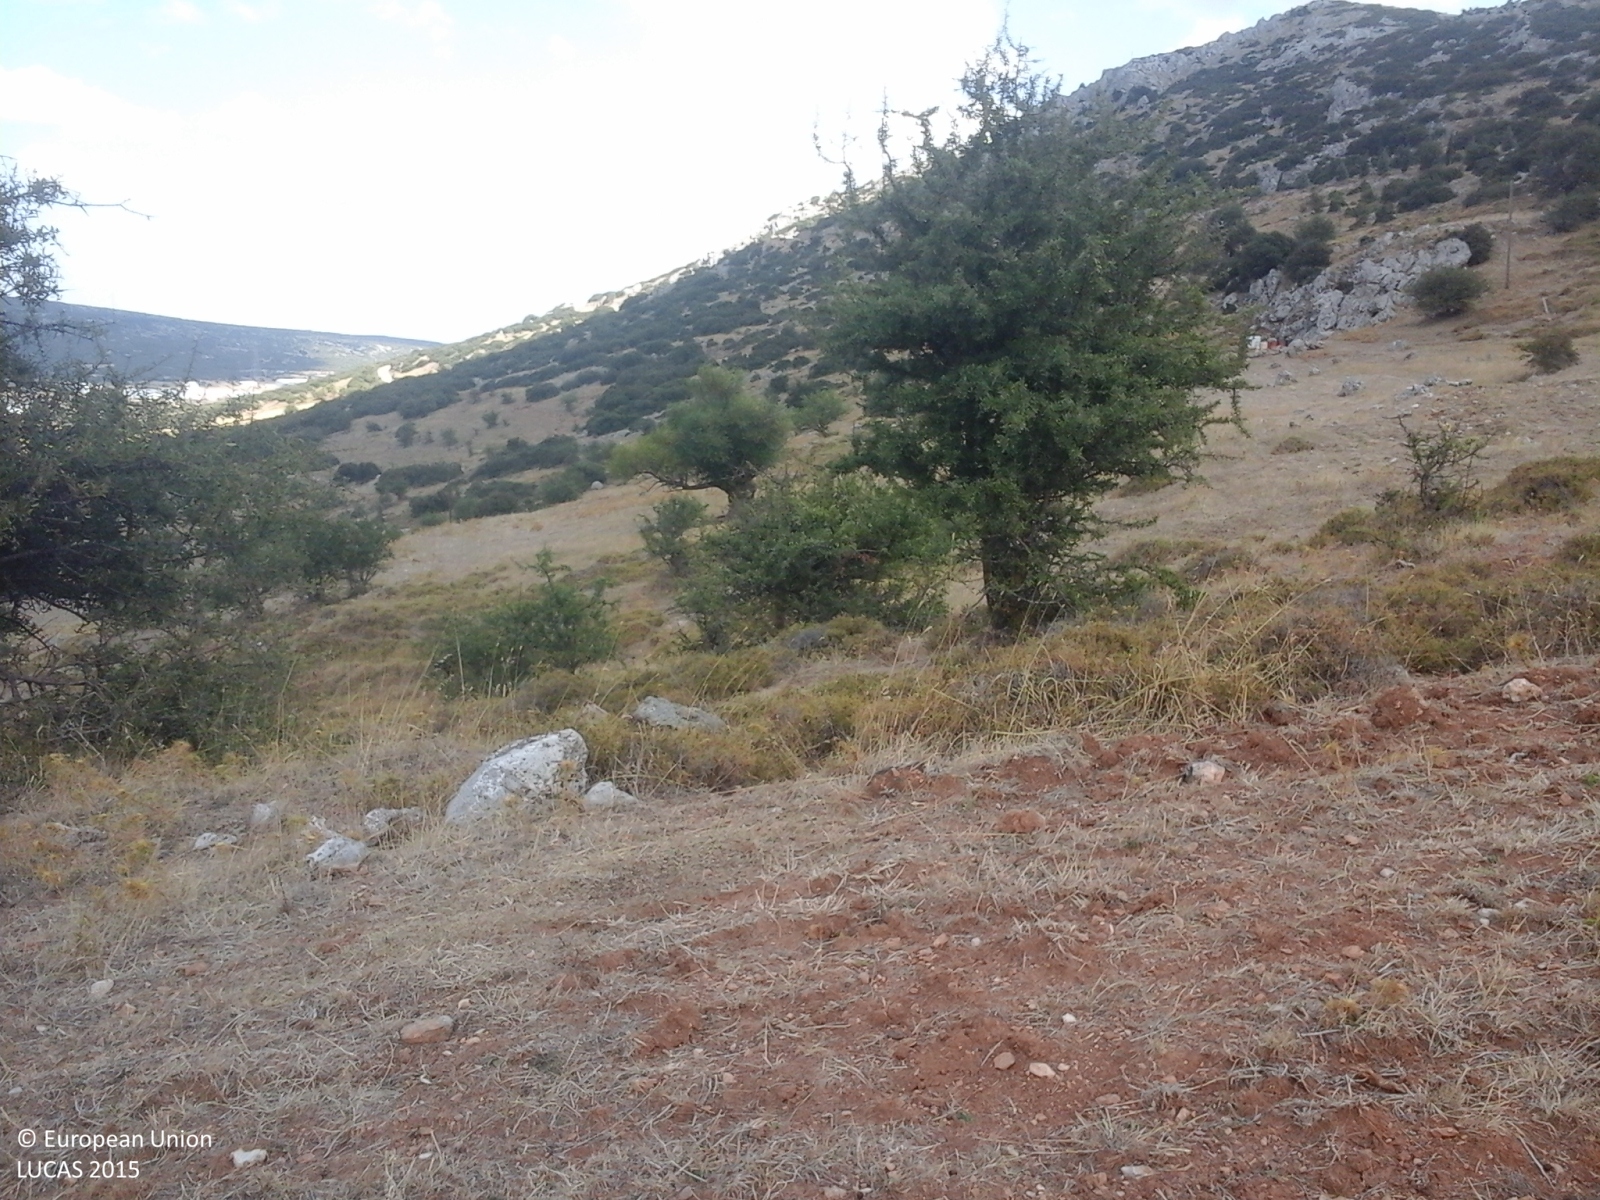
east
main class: Grassland
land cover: Spontaneously vegetated surfaces
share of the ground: > 75 %
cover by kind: herbaceous plants 85 %, unconsolidated bare surface 10 %, shrubs 5 %
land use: Agriculture (excluding fallow land and kitchen gardens)
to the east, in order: Spontaneously vegetated surfaces; Grassland with sparse tree/shrub cover; Electric lines; Grassland with sparse tree/shrub cover; Shrubland with sparse tree cover
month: September
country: GR
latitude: 38.2157
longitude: 23.4700
